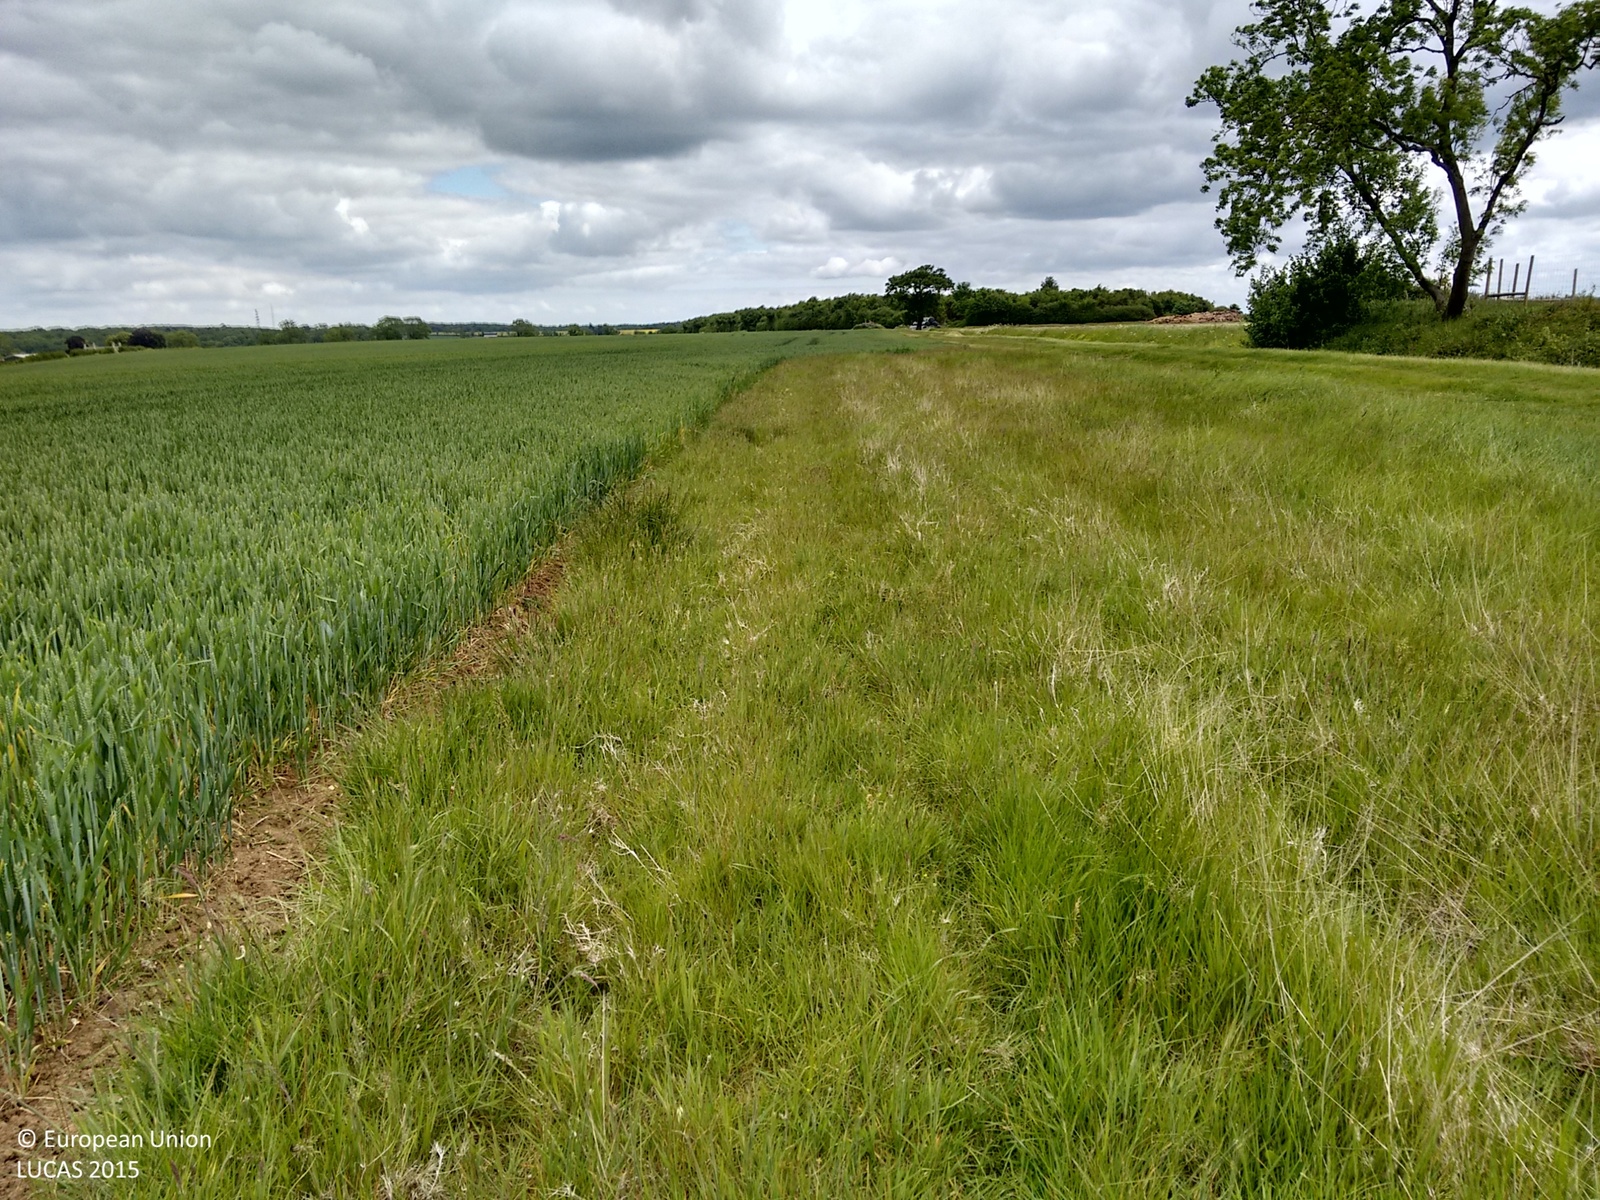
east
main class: Grassland
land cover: Grassland without tree/shrub cover
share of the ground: > 75 %
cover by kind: herbaceous plants 100 %
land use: Agriculture (excluding fallow land and kitchen gardens)
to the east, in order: Grassland without tree/shrub cover; Tracks; Grass margins; Ditches and canals; Grassland without tree/shrub cover
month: June
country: GB
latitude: 52.8199
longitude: -0.4692
